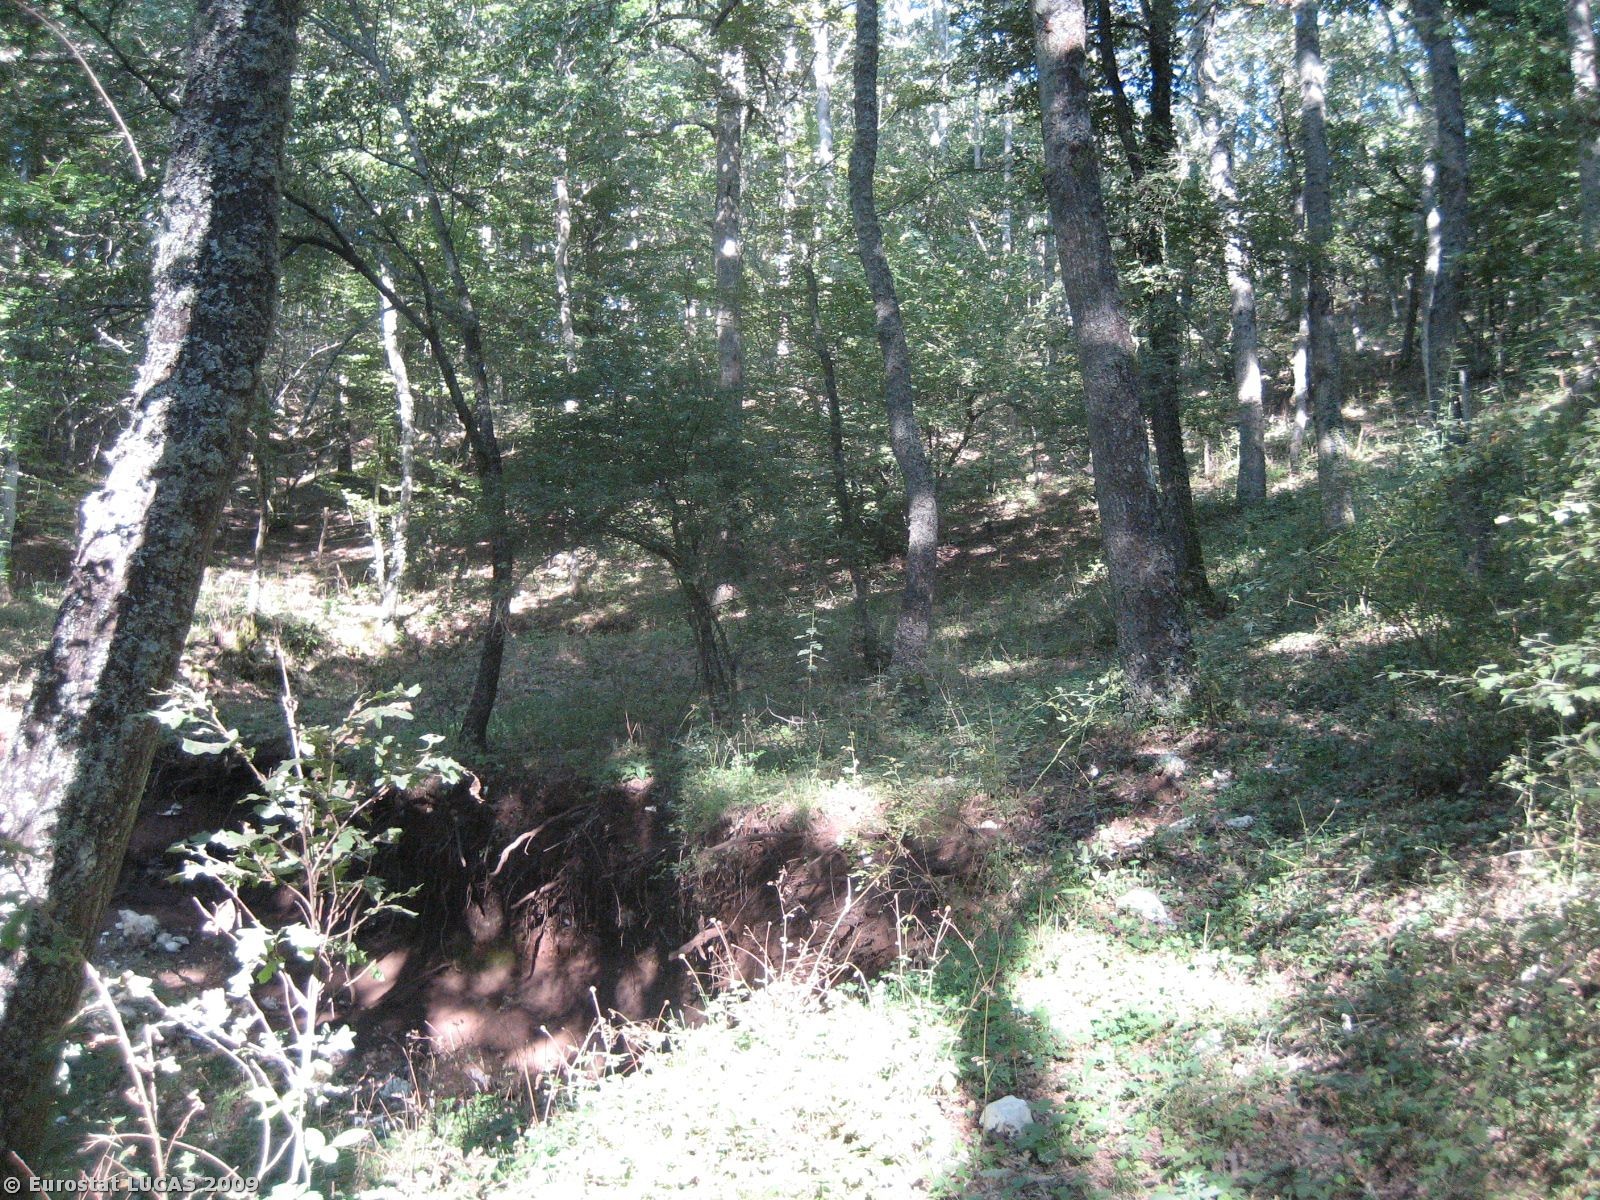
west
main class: Woodland
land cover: Broadleaved woodland
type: mesophytic deciduous forest
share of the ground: > 75 %
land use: Agriculture (excluding fallow land and kitchen gardens)
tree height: > 5 m
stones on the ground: 10 - 25 %
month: July
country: IT
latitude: 41.7167
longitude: 15.6682
